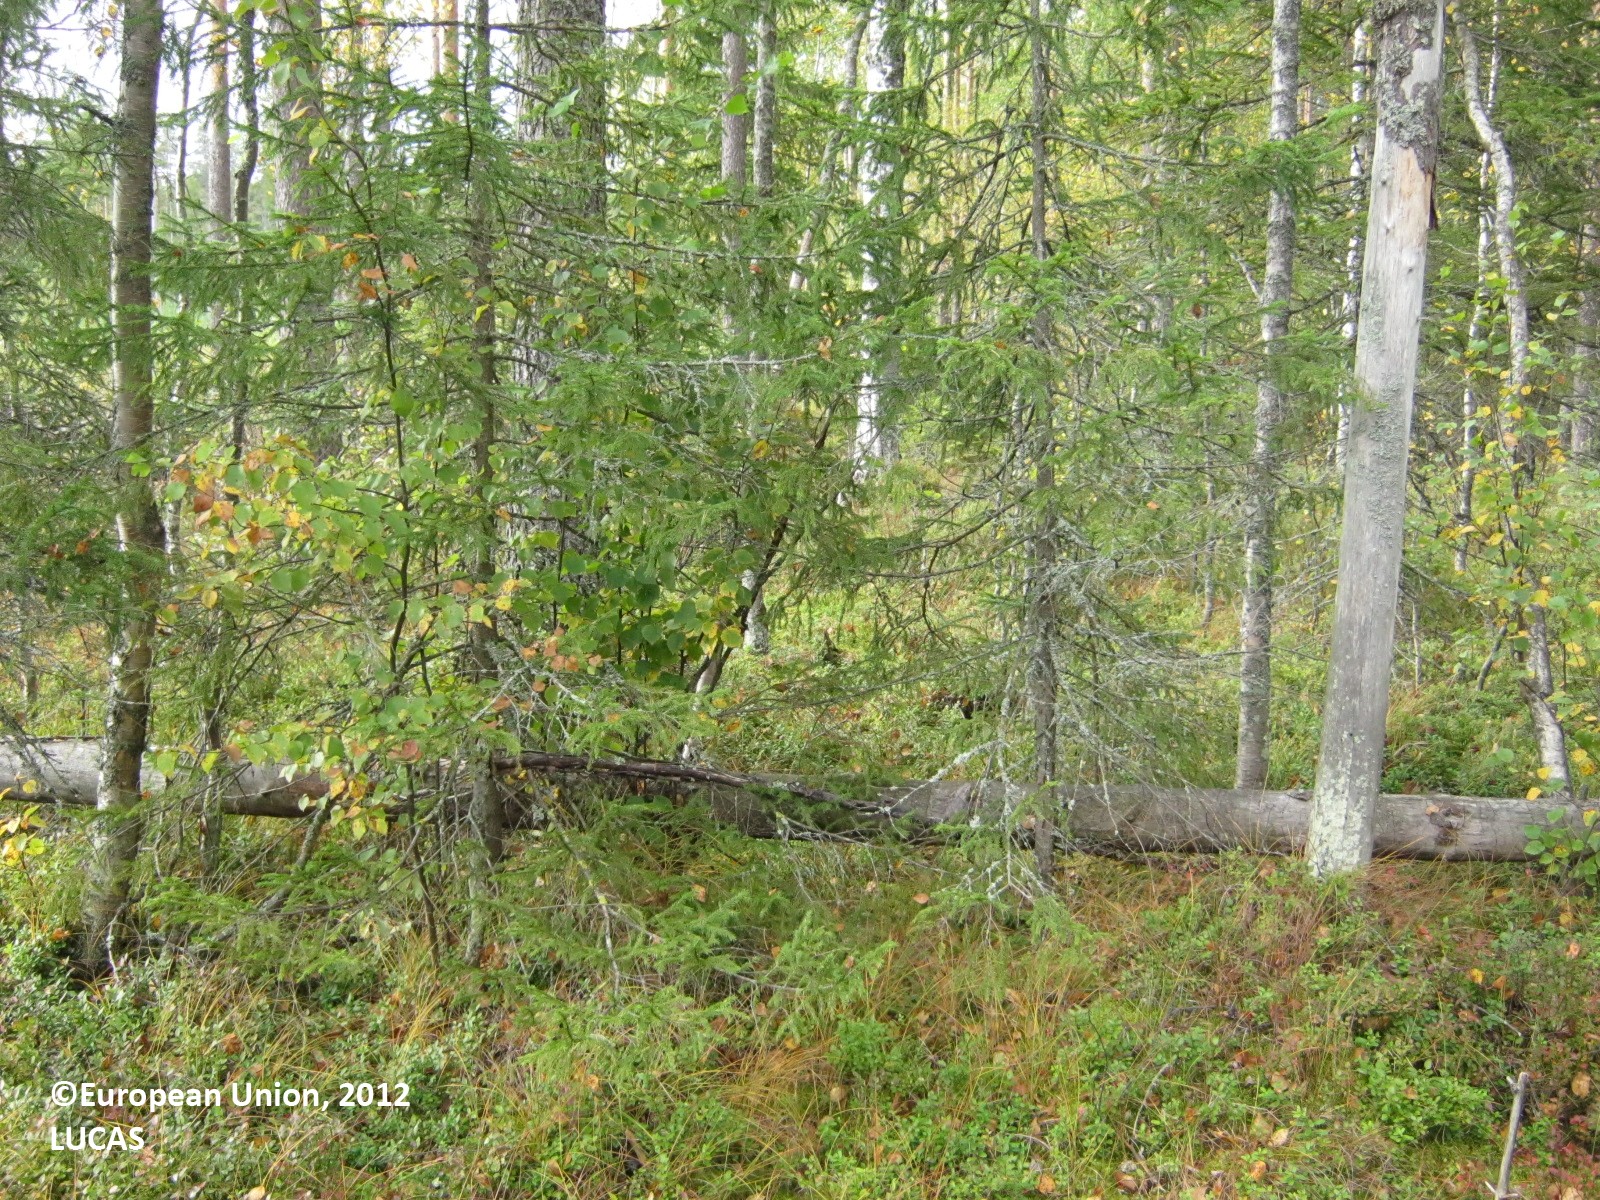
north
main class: Woodland
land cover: Other mixed woodland
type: boreal forest
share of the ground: > 75 %
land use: Forestry
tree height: > 5 m
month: September
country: FI
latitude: 60.8416
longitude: 27.5734
